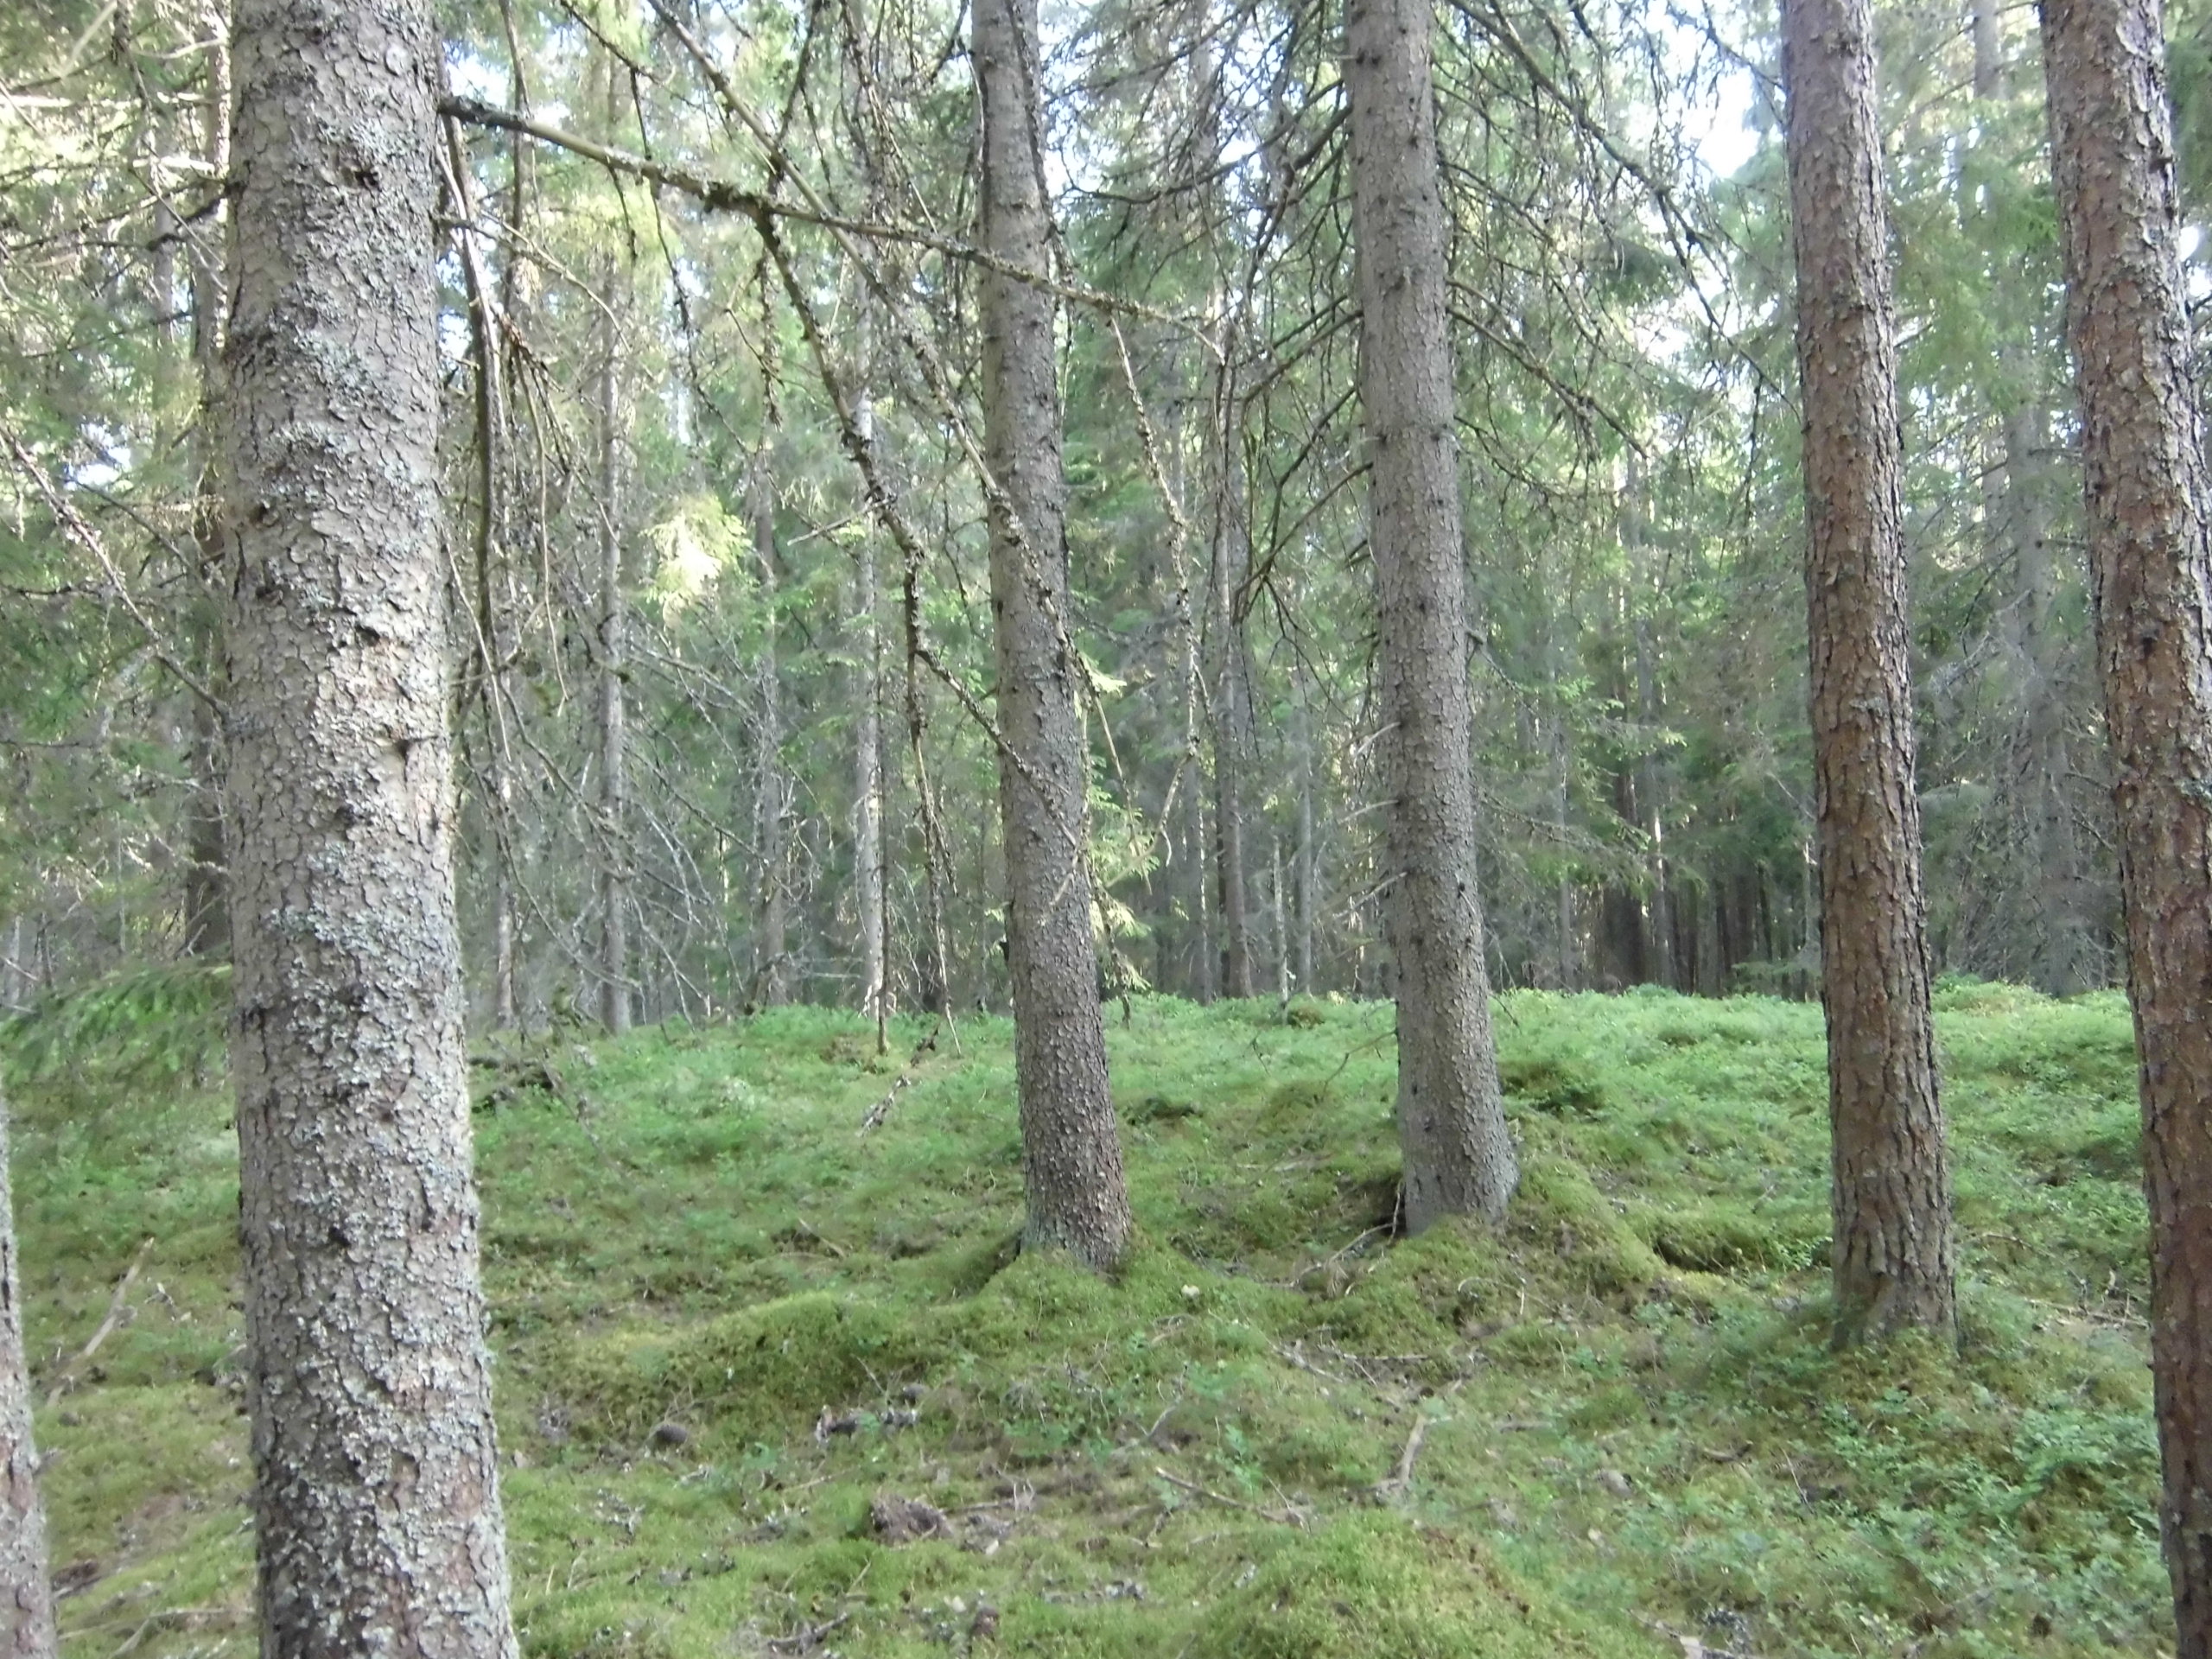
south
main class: Woodland
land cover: Spruce dominated coniferous woodland
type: boreal forest
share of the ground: 50 - 75 %
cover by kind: coniferous forest trees 55 %, lichens and mosses 25 %, shrubs 20 %
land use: Forestry
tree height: > 5 m
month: July
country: SE
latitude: 57.3447
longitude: 14.6986
